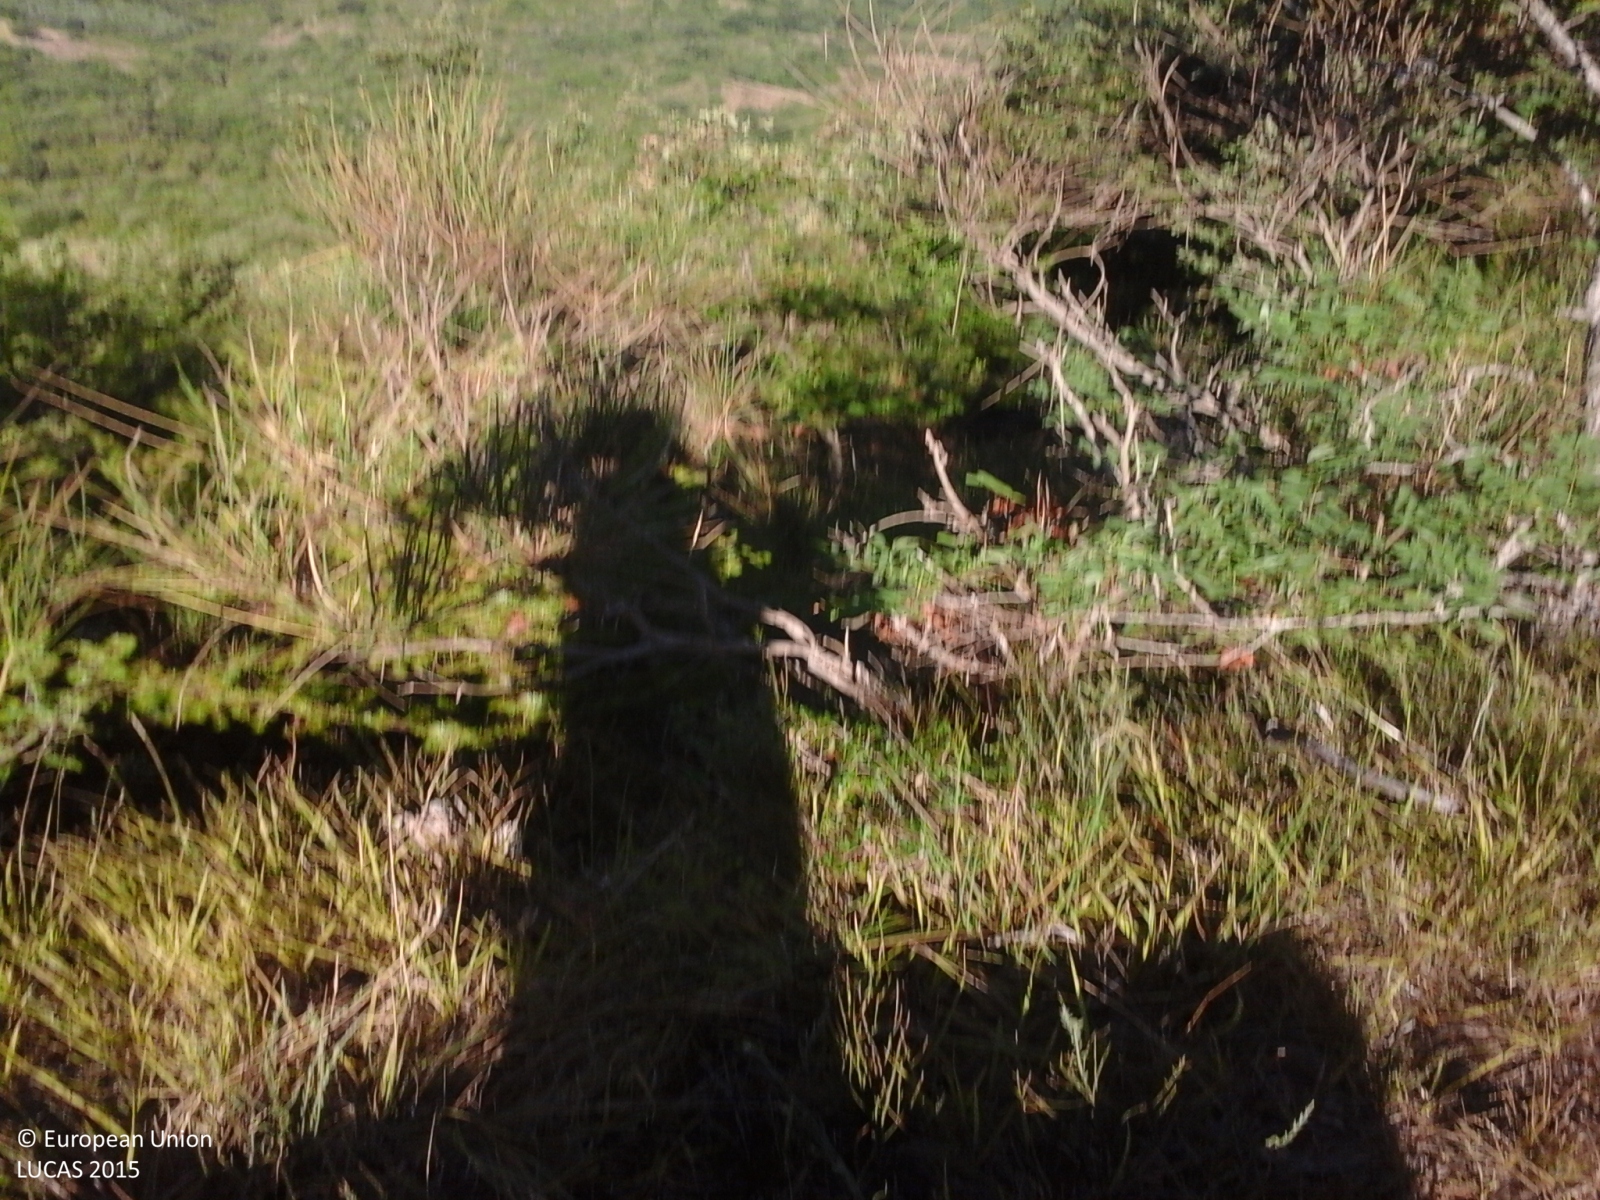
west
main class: Woodland
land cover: Broadleaved woodland
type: thermophilous deciduous forest
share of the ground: > 75 %
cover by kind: broadleaved forest trees 75 %, shrubs 20 %, herbaceous plants 5 %
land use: Forestry
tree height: > 5 m
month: August
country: IT
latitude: 42.7679
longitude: 11.5958
